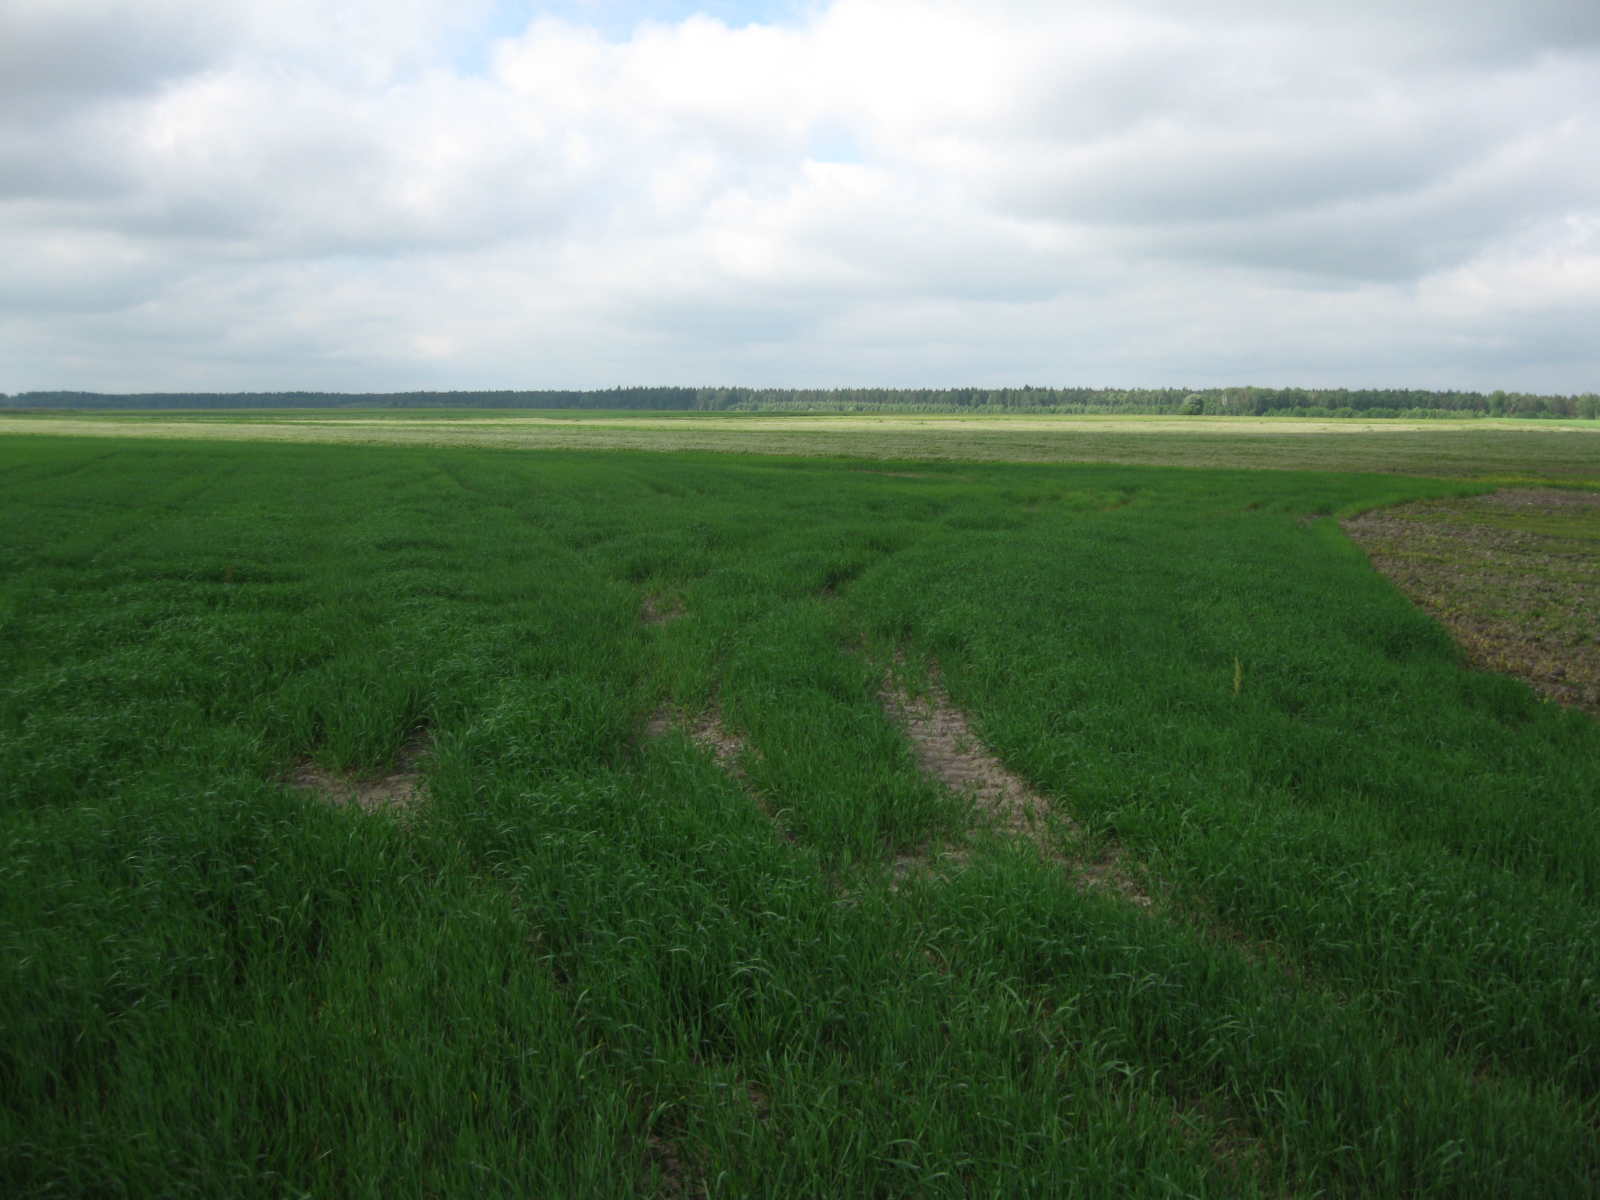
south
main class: Cropland
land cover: Barley
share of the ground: > 75 %
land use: Agriculture (excluding fallow land and kitchen gardens)
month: June
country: LT
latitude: 56.1885
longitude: 24.9152
